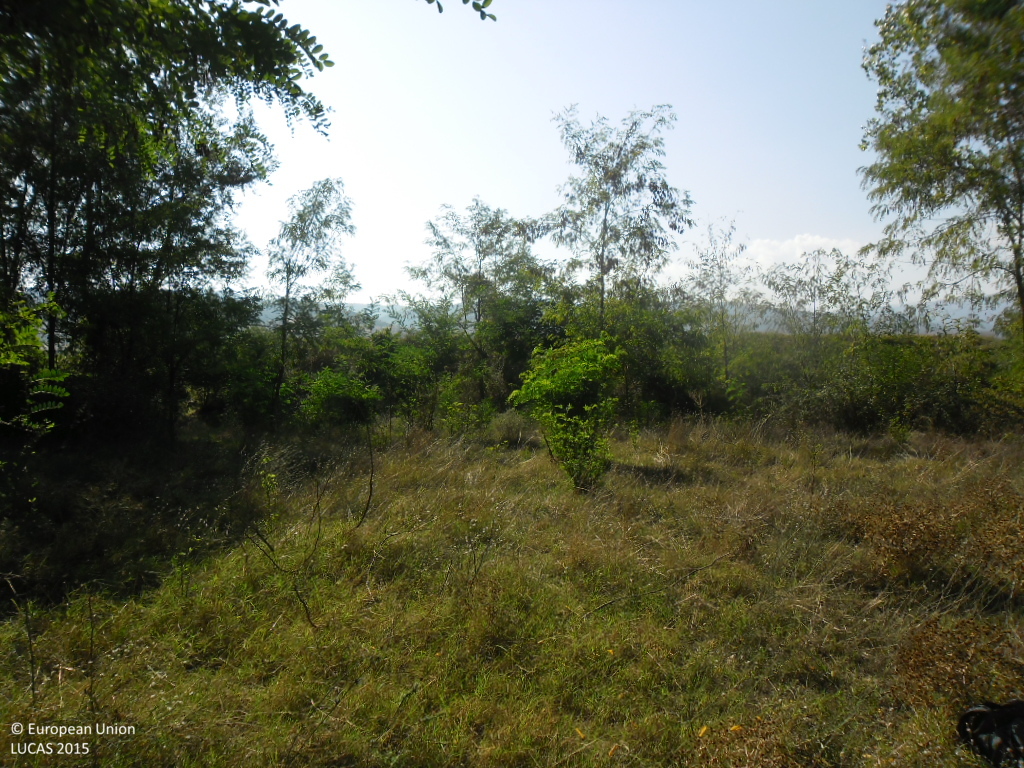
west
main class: Woodland
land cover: Broadleaved woodland
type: mesophytic deciduous forest
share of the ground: > 75 %
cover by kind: broadleaved forest trees 95 %, shrubs 5 %
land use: Forestry
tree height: < 5 m
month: September
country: BG
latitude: 41.6199
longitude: 23.2113
